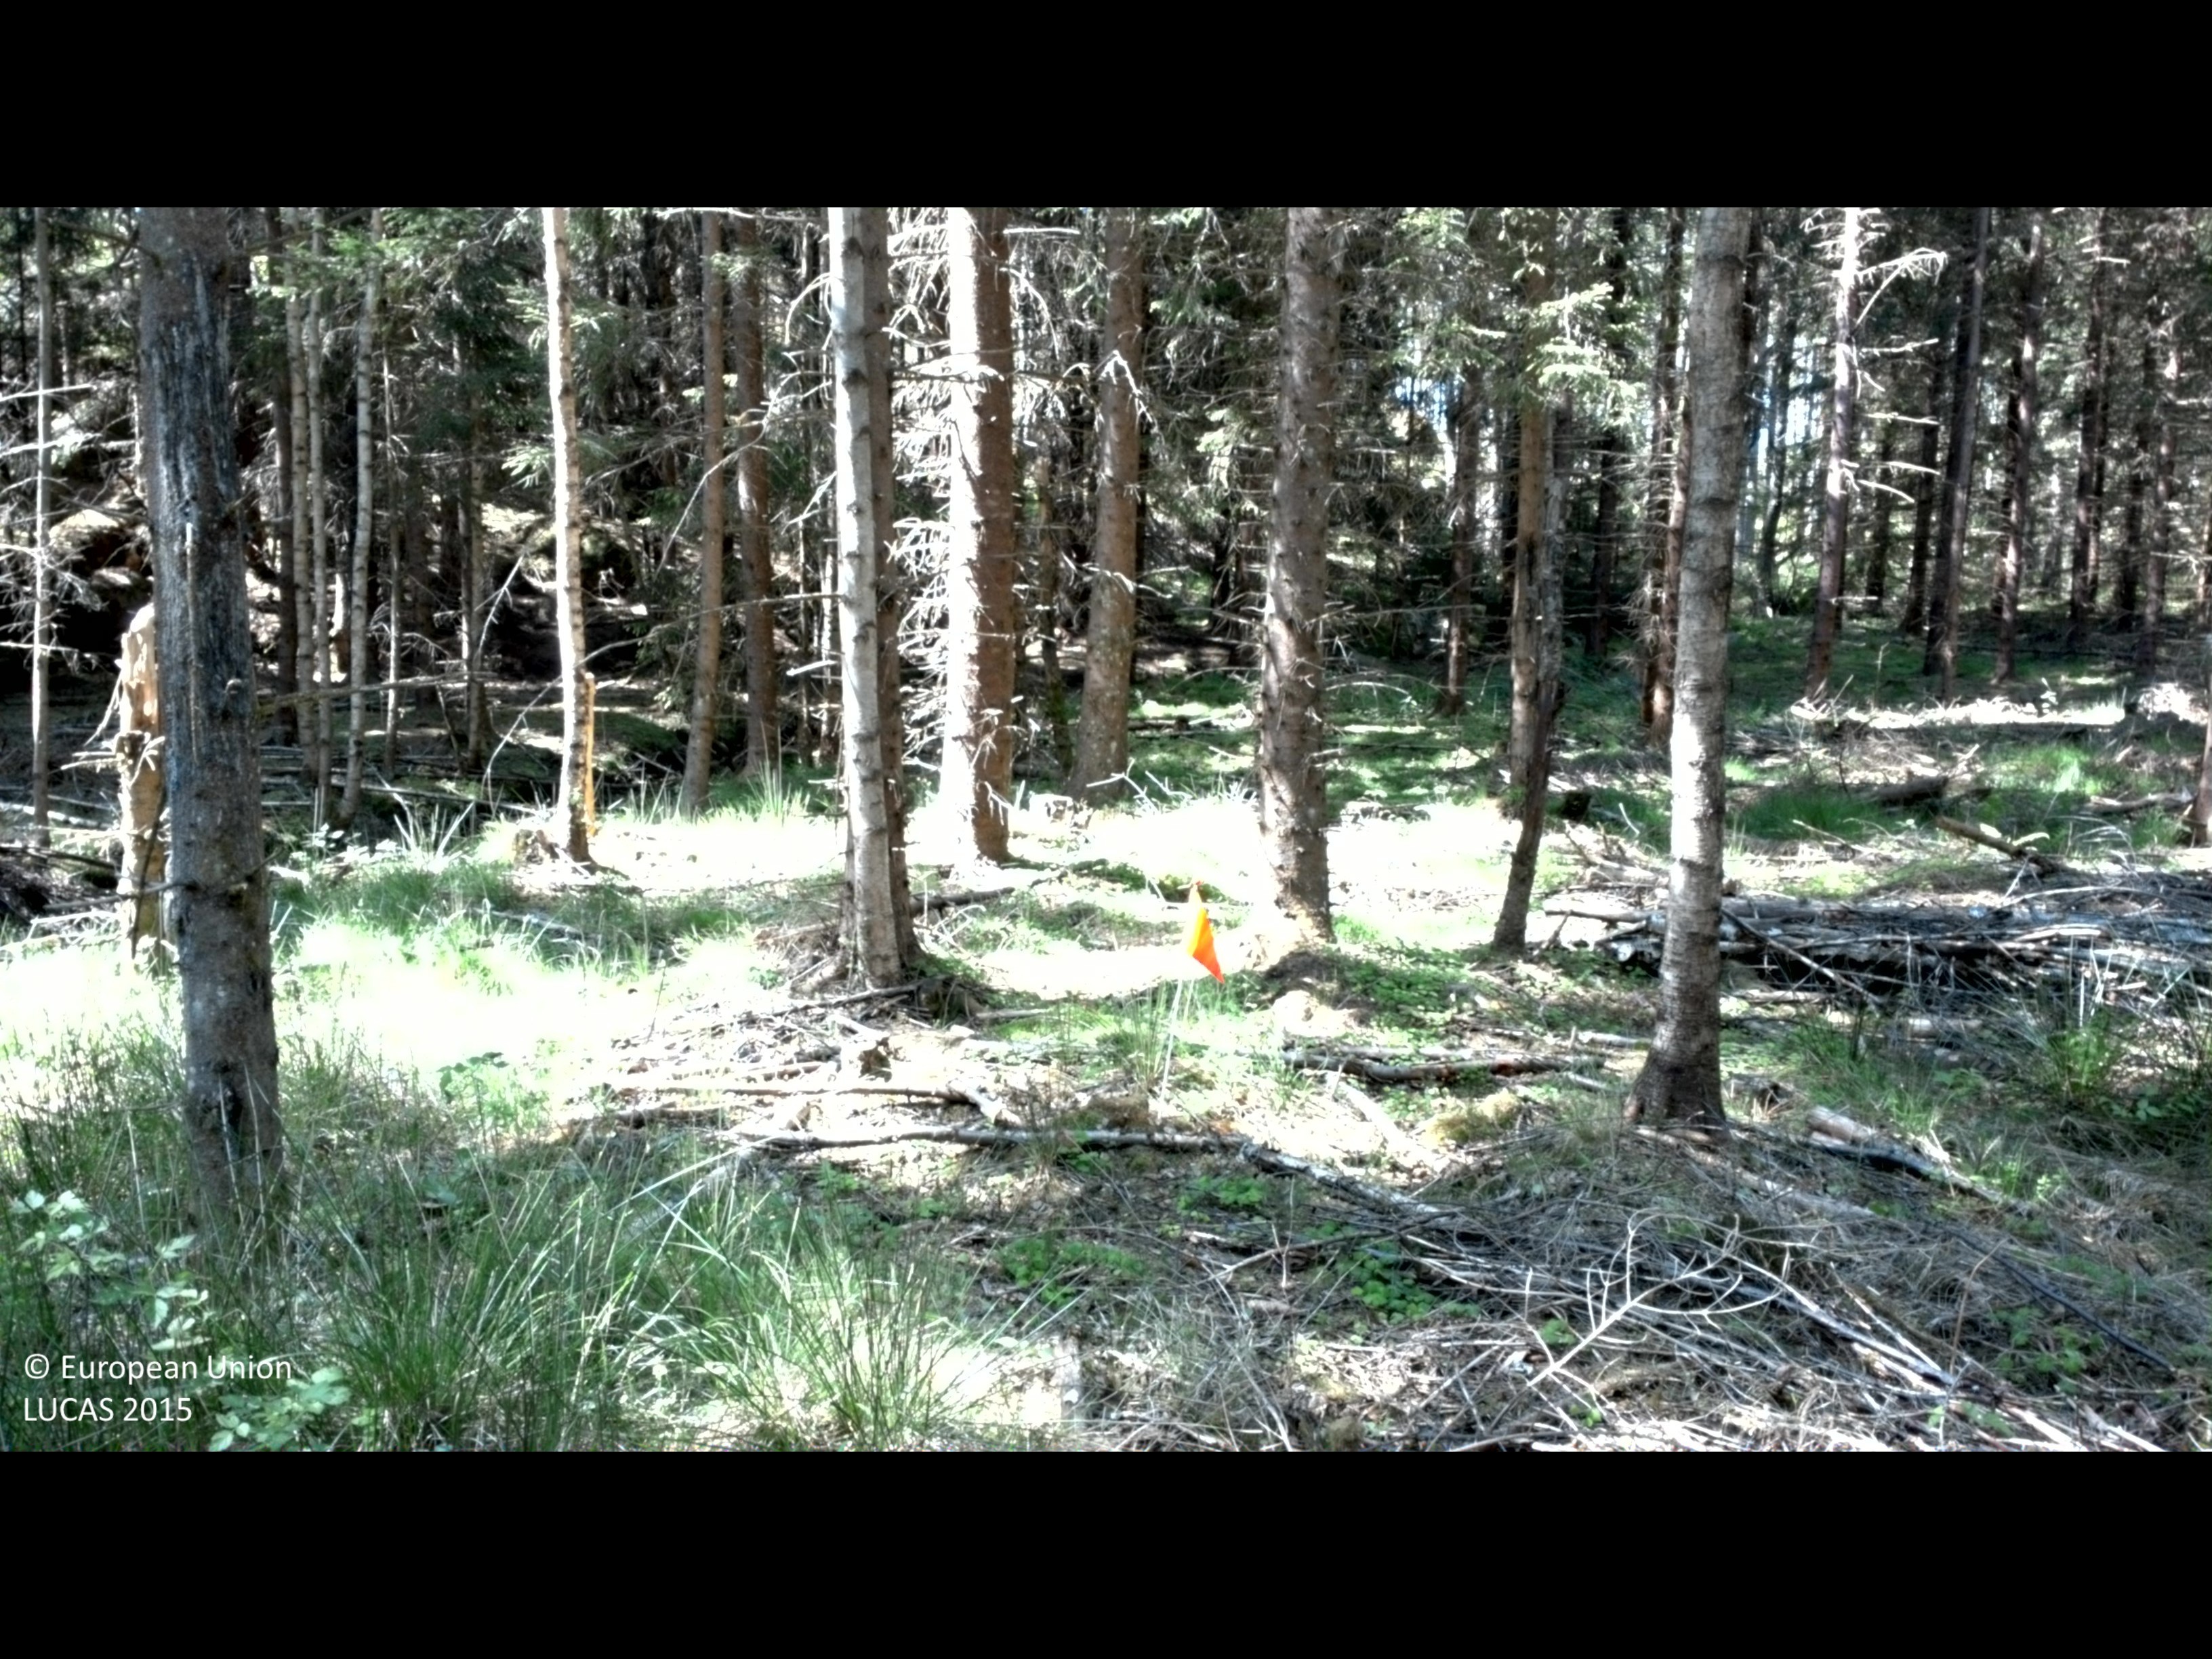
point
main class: Woodland
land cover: Spruce dominated coniferous woodland
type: boreal forest
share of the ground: 50 - 75 %
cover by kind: coniferous forest trees 55 %, herbaceous plants 25 %, broadleaved forest trees 10 %, unconsolidated bare surface 5 %
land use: Forestry
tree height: > 5 m
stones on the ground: < 10 %
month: June
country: SE
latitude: 57.7518
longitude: 16.1980
